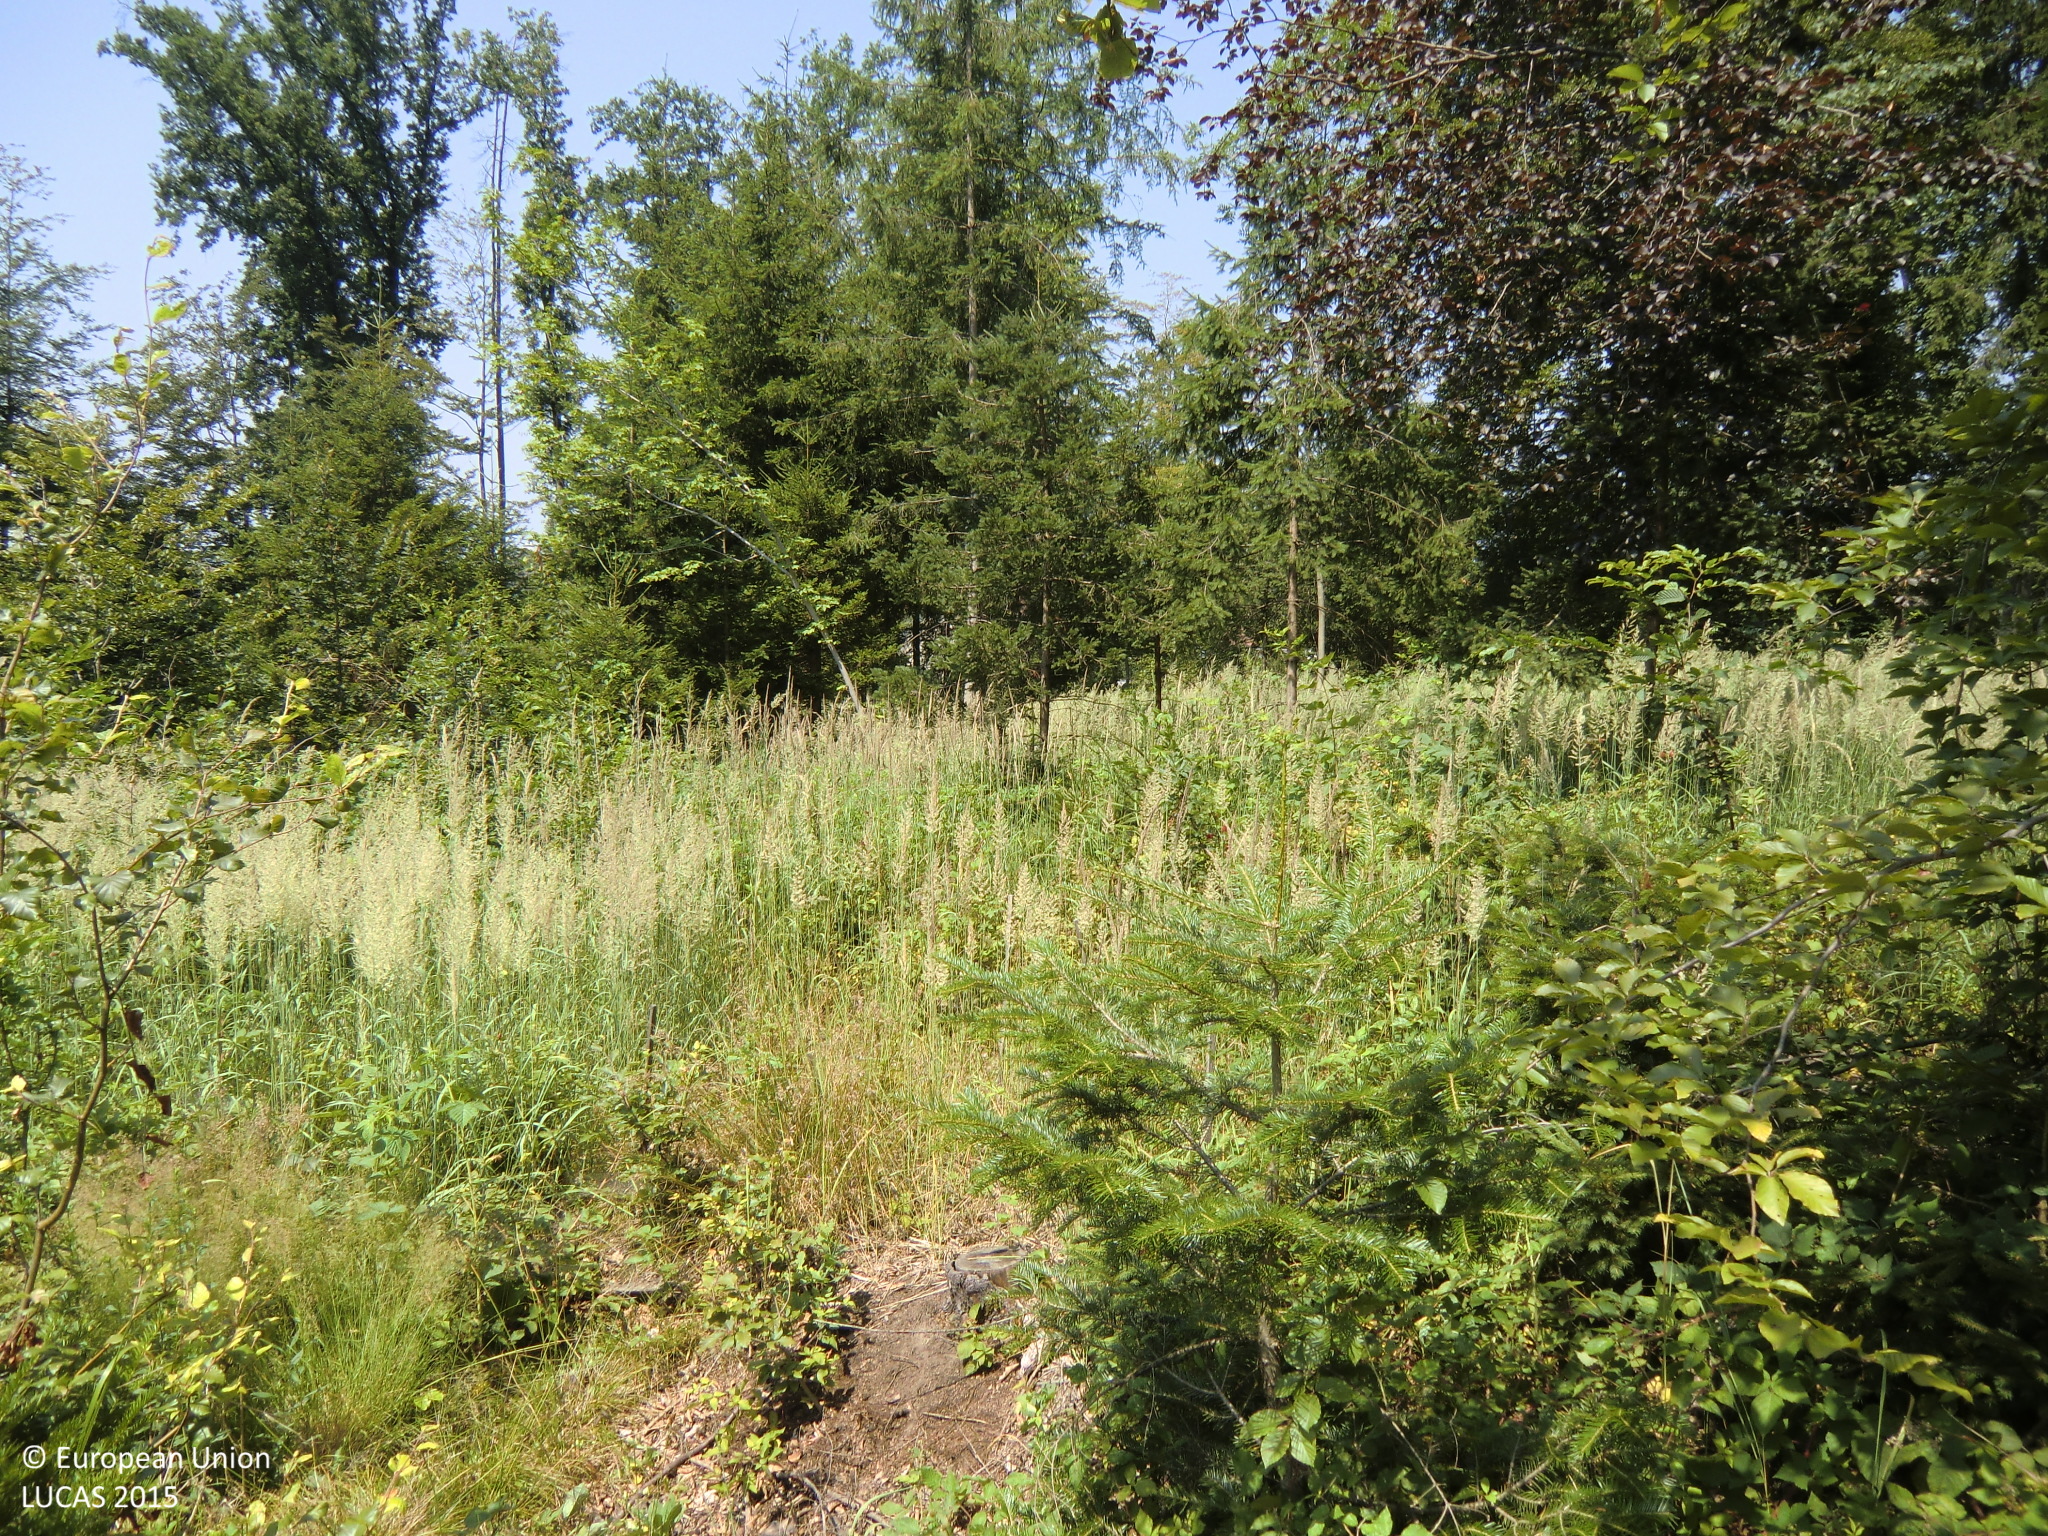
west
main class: Shrubland
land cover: Shrubland with sparse tree cover
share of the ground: > 75 %
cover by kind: herbaceous plants 55 %, shrubs 40 %, broadleaved forest trees 5 %
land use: Forestry
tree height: < 5 m
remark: Clear cut
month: July
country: AT
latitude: 47.1001
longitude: 15.7320
